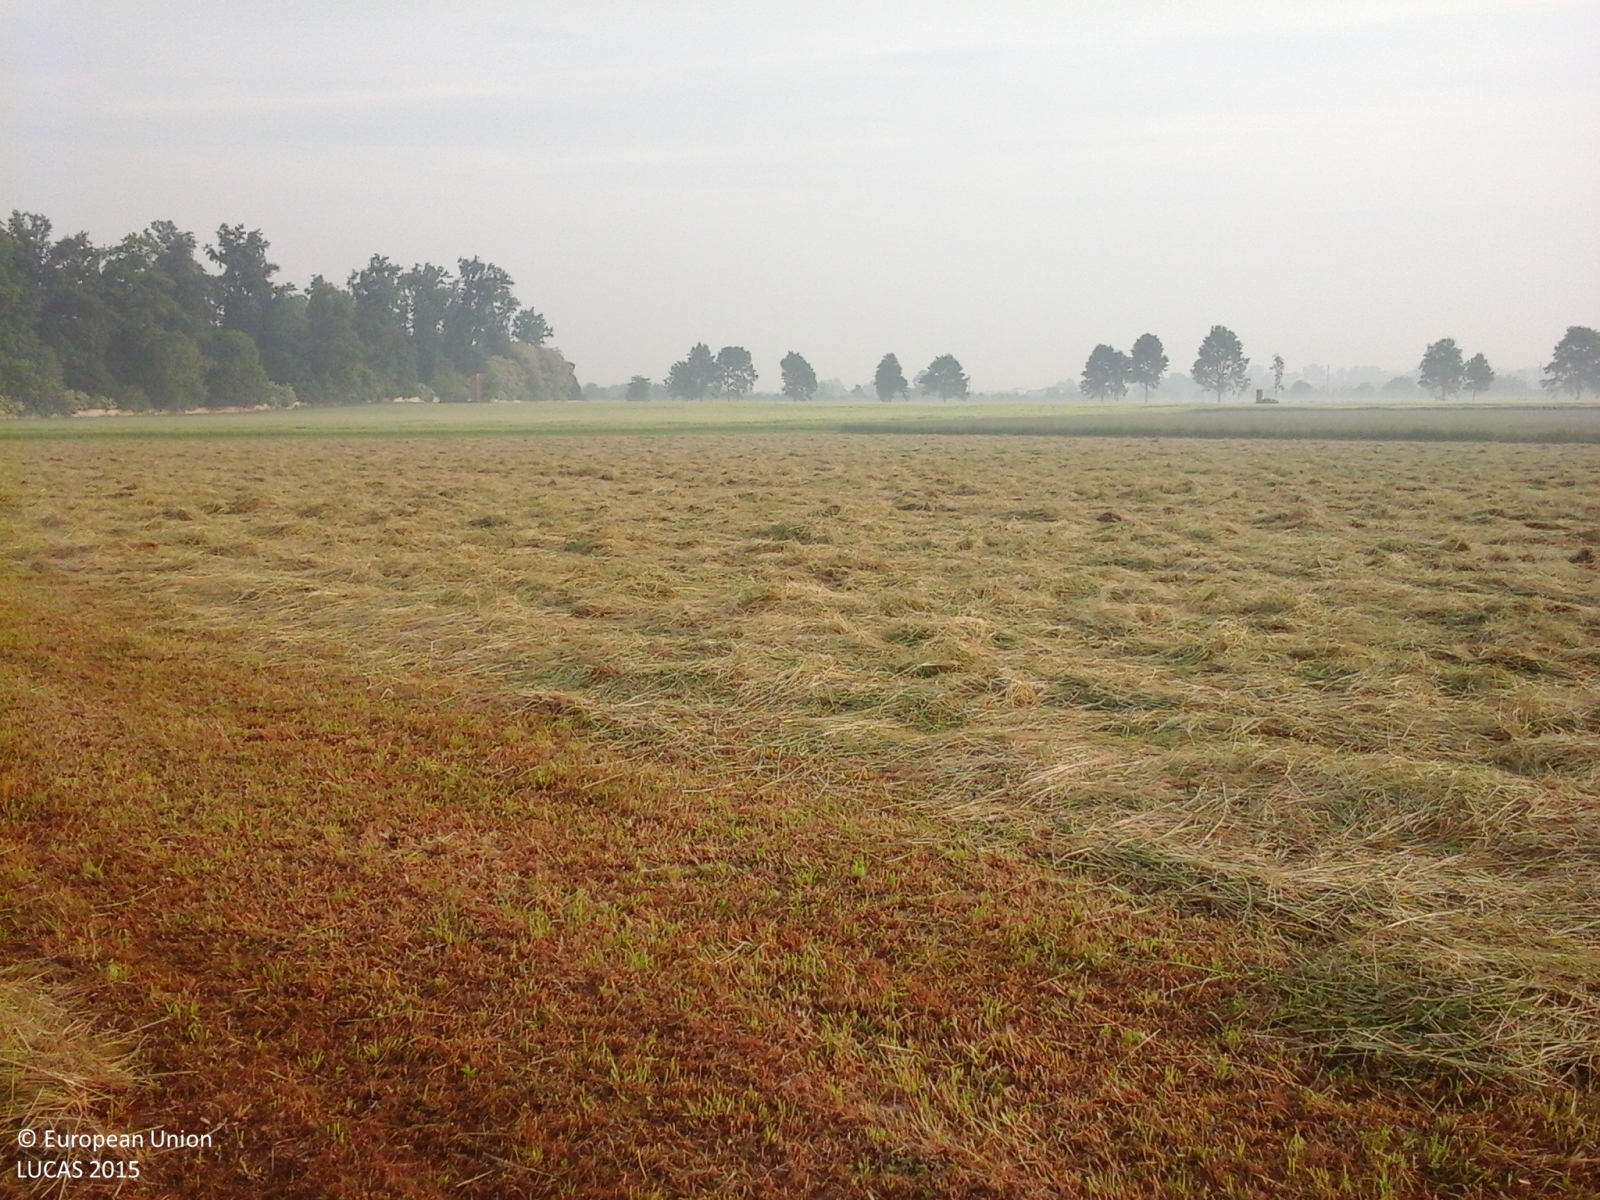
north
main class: Cropland
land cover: Temporary grasslands
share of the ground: > 75 %
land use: Agriculture (excluding fallow land and kitchen gardens)
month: May
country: IT
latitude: 44.9031
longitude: 7.7372
